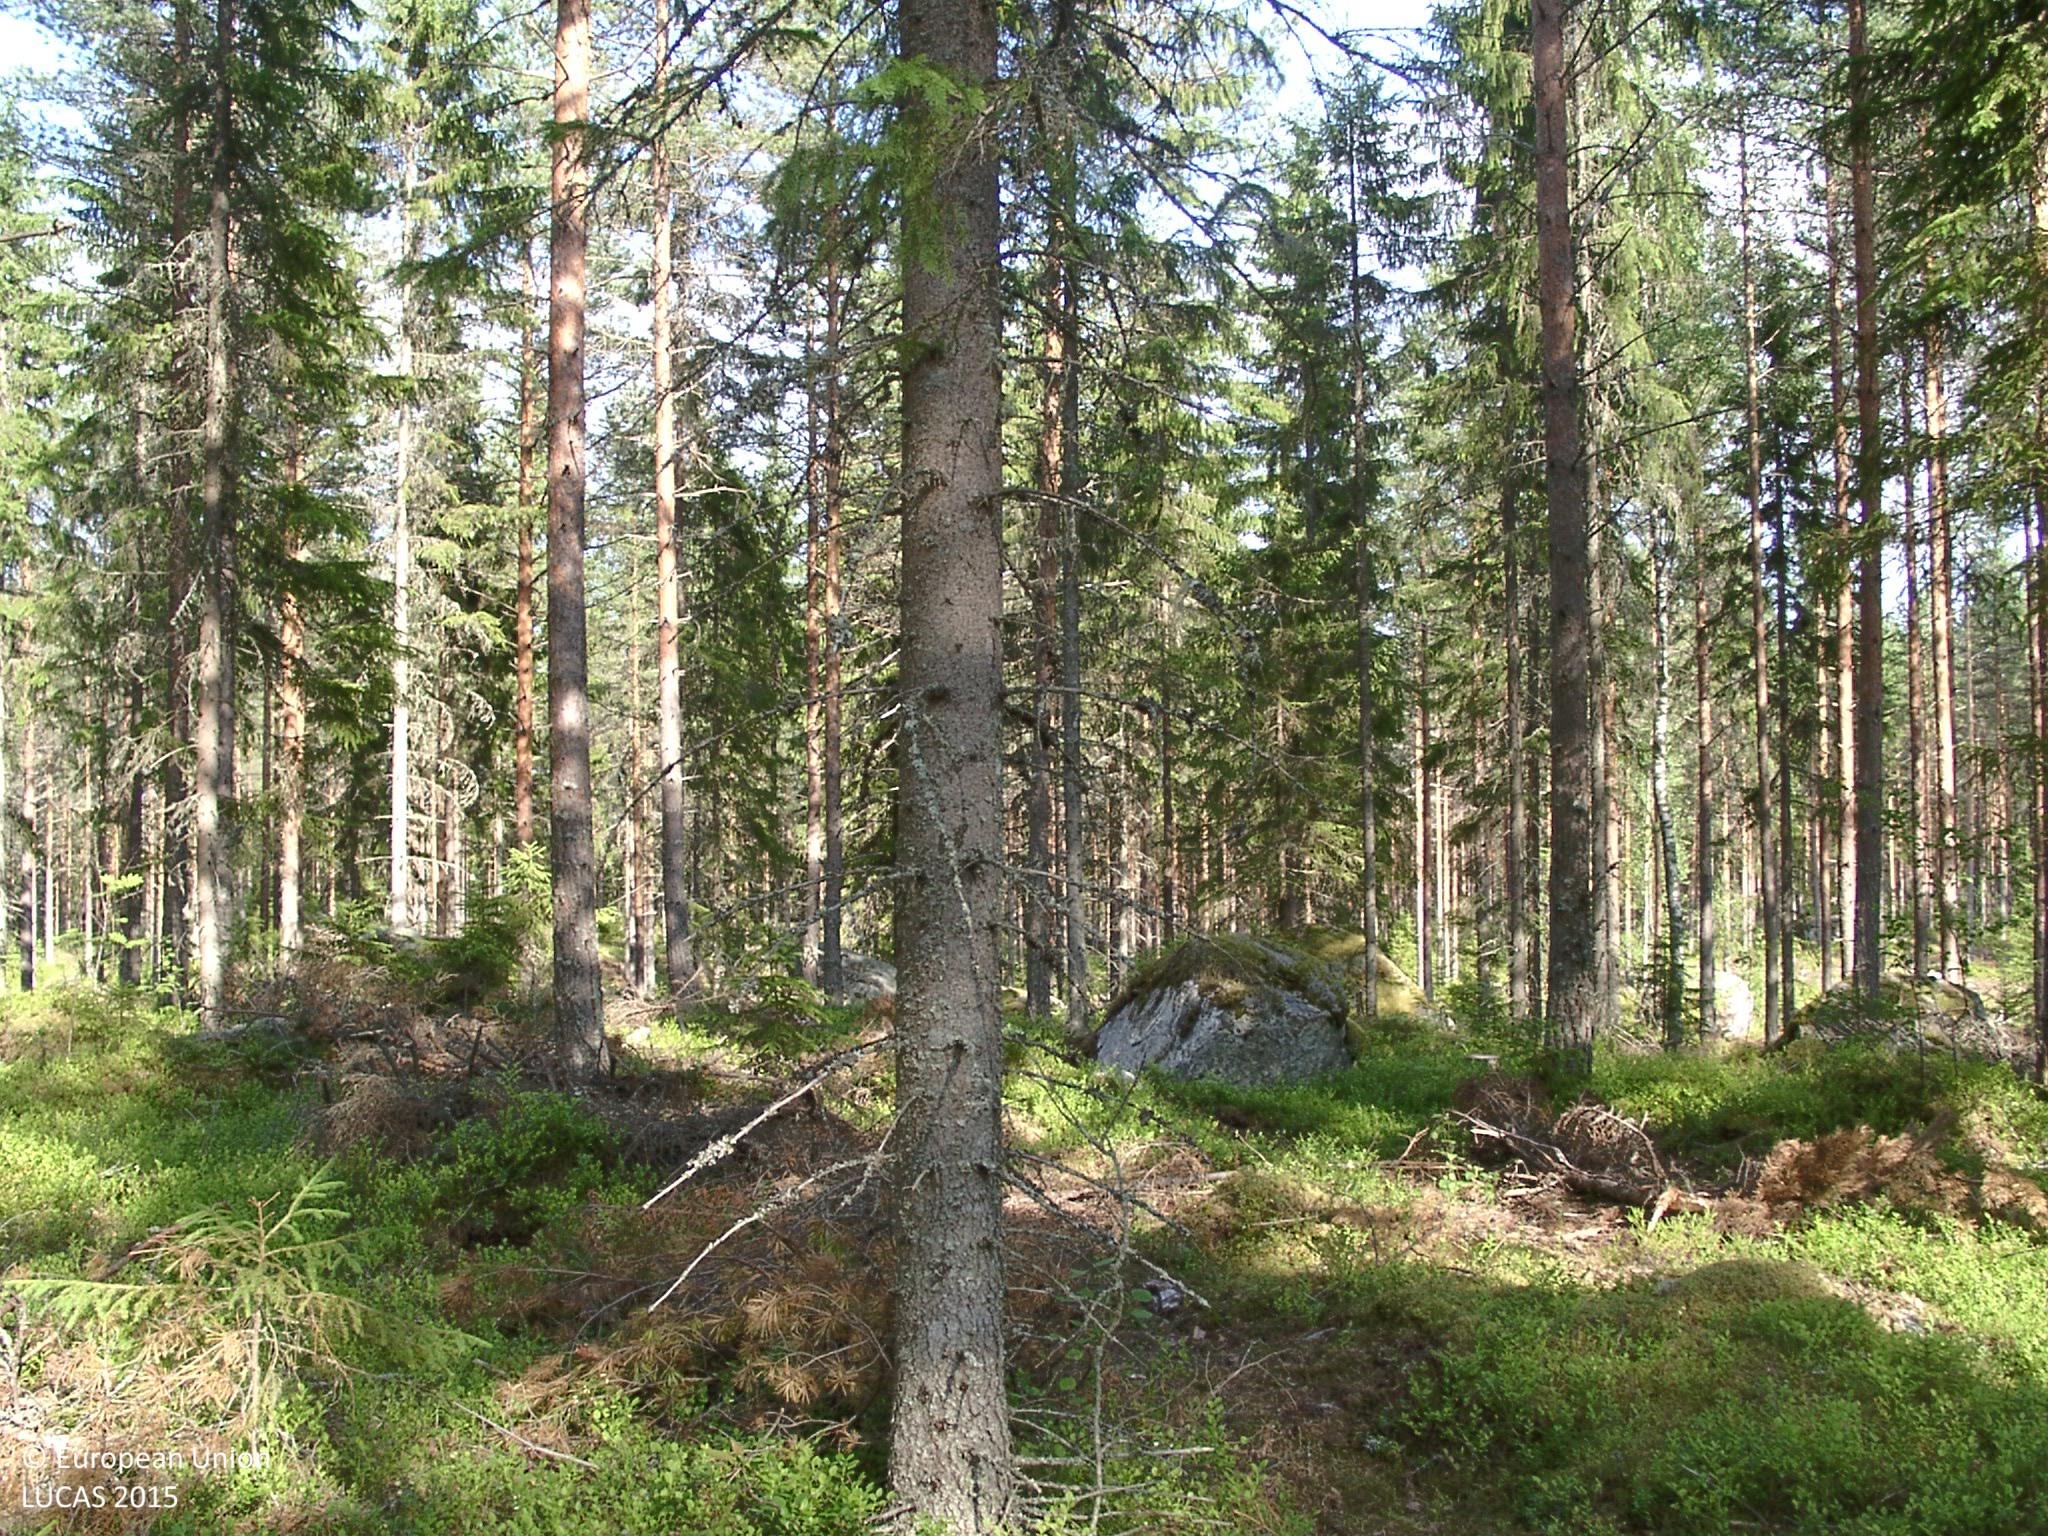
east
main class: Woodland
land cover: Other coniferous woodland
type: boreal forest
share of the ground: 50 - 75 %
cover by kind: coniferous forest trees 60 %, shrubs 25 %, lichens and mosses 10 %
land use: Forestry
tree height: > 5 m
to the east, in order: Tracks; Other coniferous woodland; Tracks; Other coniferous woodland; Tracks; Shrubland with sparse tree cover; Tracks; Pine dominated coniferous woodland; Tracks; Pine dominated coniferous woodland; Tracks; Other coniferous woodland; Spruce dominated coniferous woodland; Grass margins; Spruce dominated coniferous woodland; Shruby margins; Spruce dominated mixed woodland; Grass margins; Spruce dominated mixed woodland
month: July
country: FI
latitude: 61.6210
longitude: 25.2975
